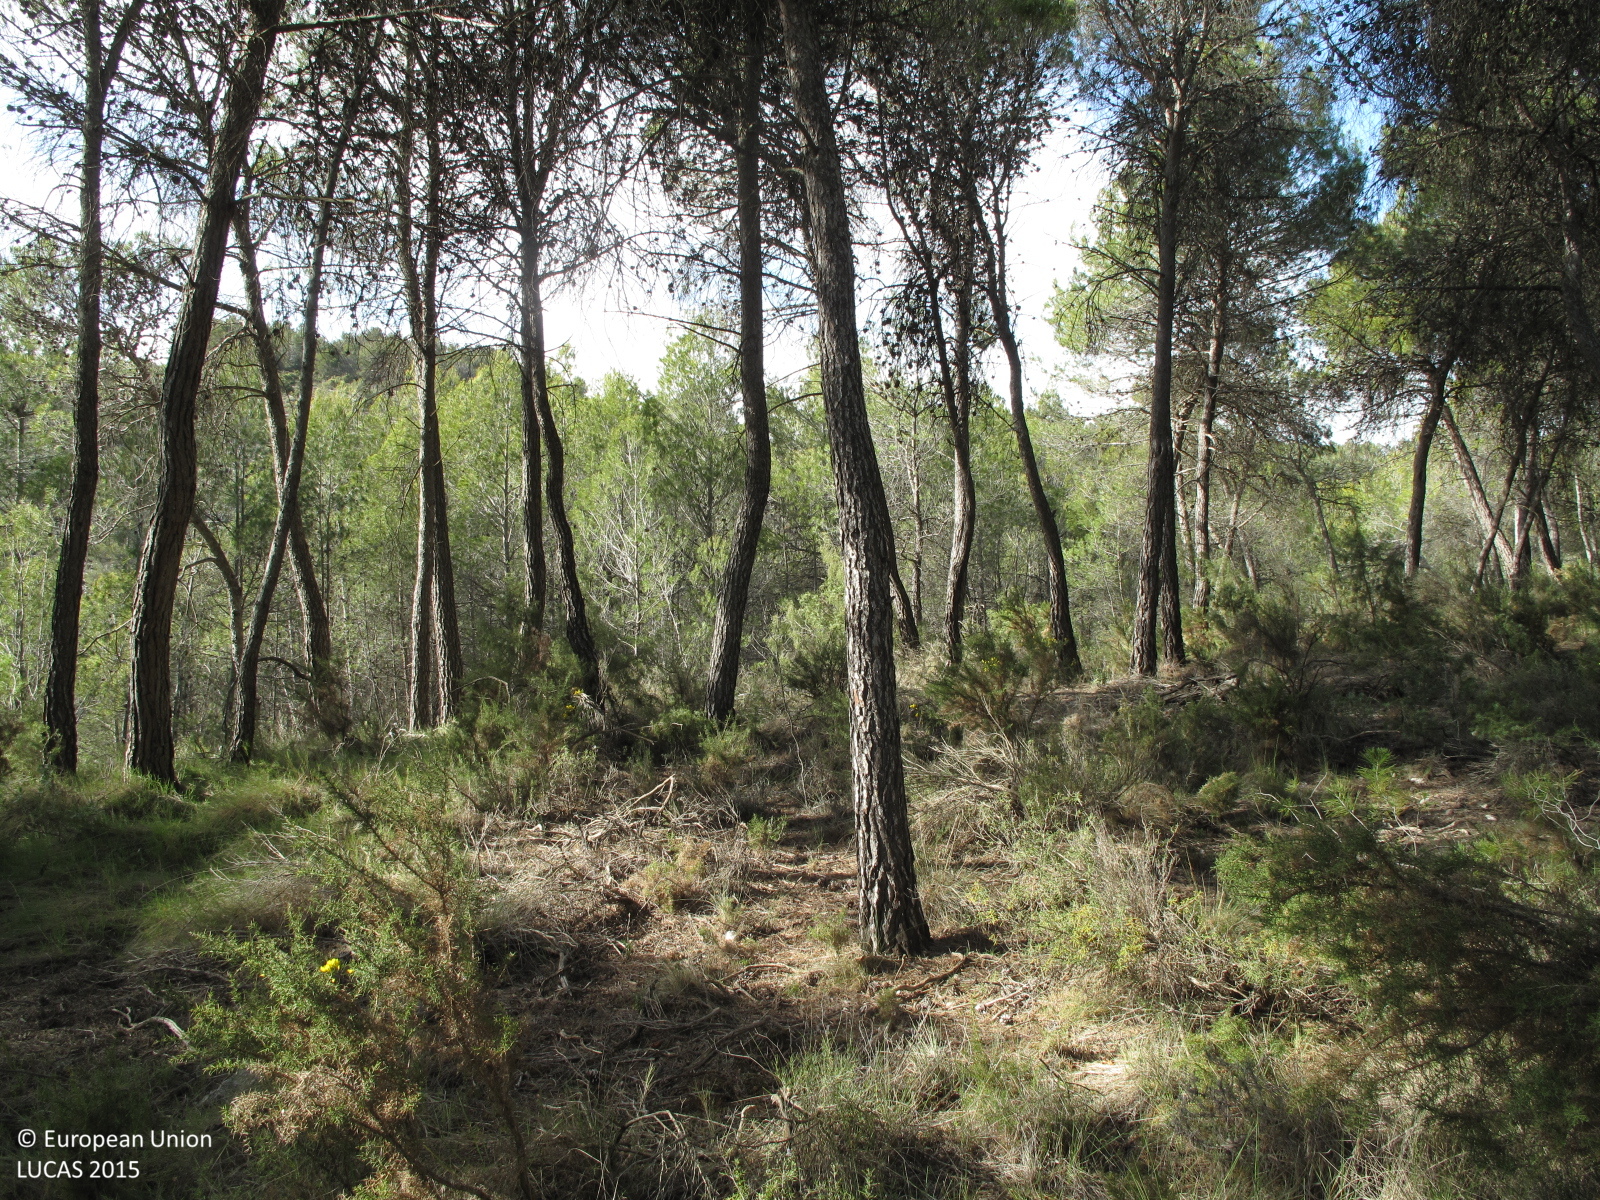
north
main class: Woodland
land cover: Pine dominated coniferous woodland
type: coniferous forest of the mediterranean region
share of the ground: > 75 %
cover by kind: coniferous forest trees 80 %, shrubs 10 %, herbaceous plants 10 %
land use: Semi-natural and natural areas not in use
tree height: > 5 m
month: March
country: ES
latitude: 38.7158
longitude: -0.5129
